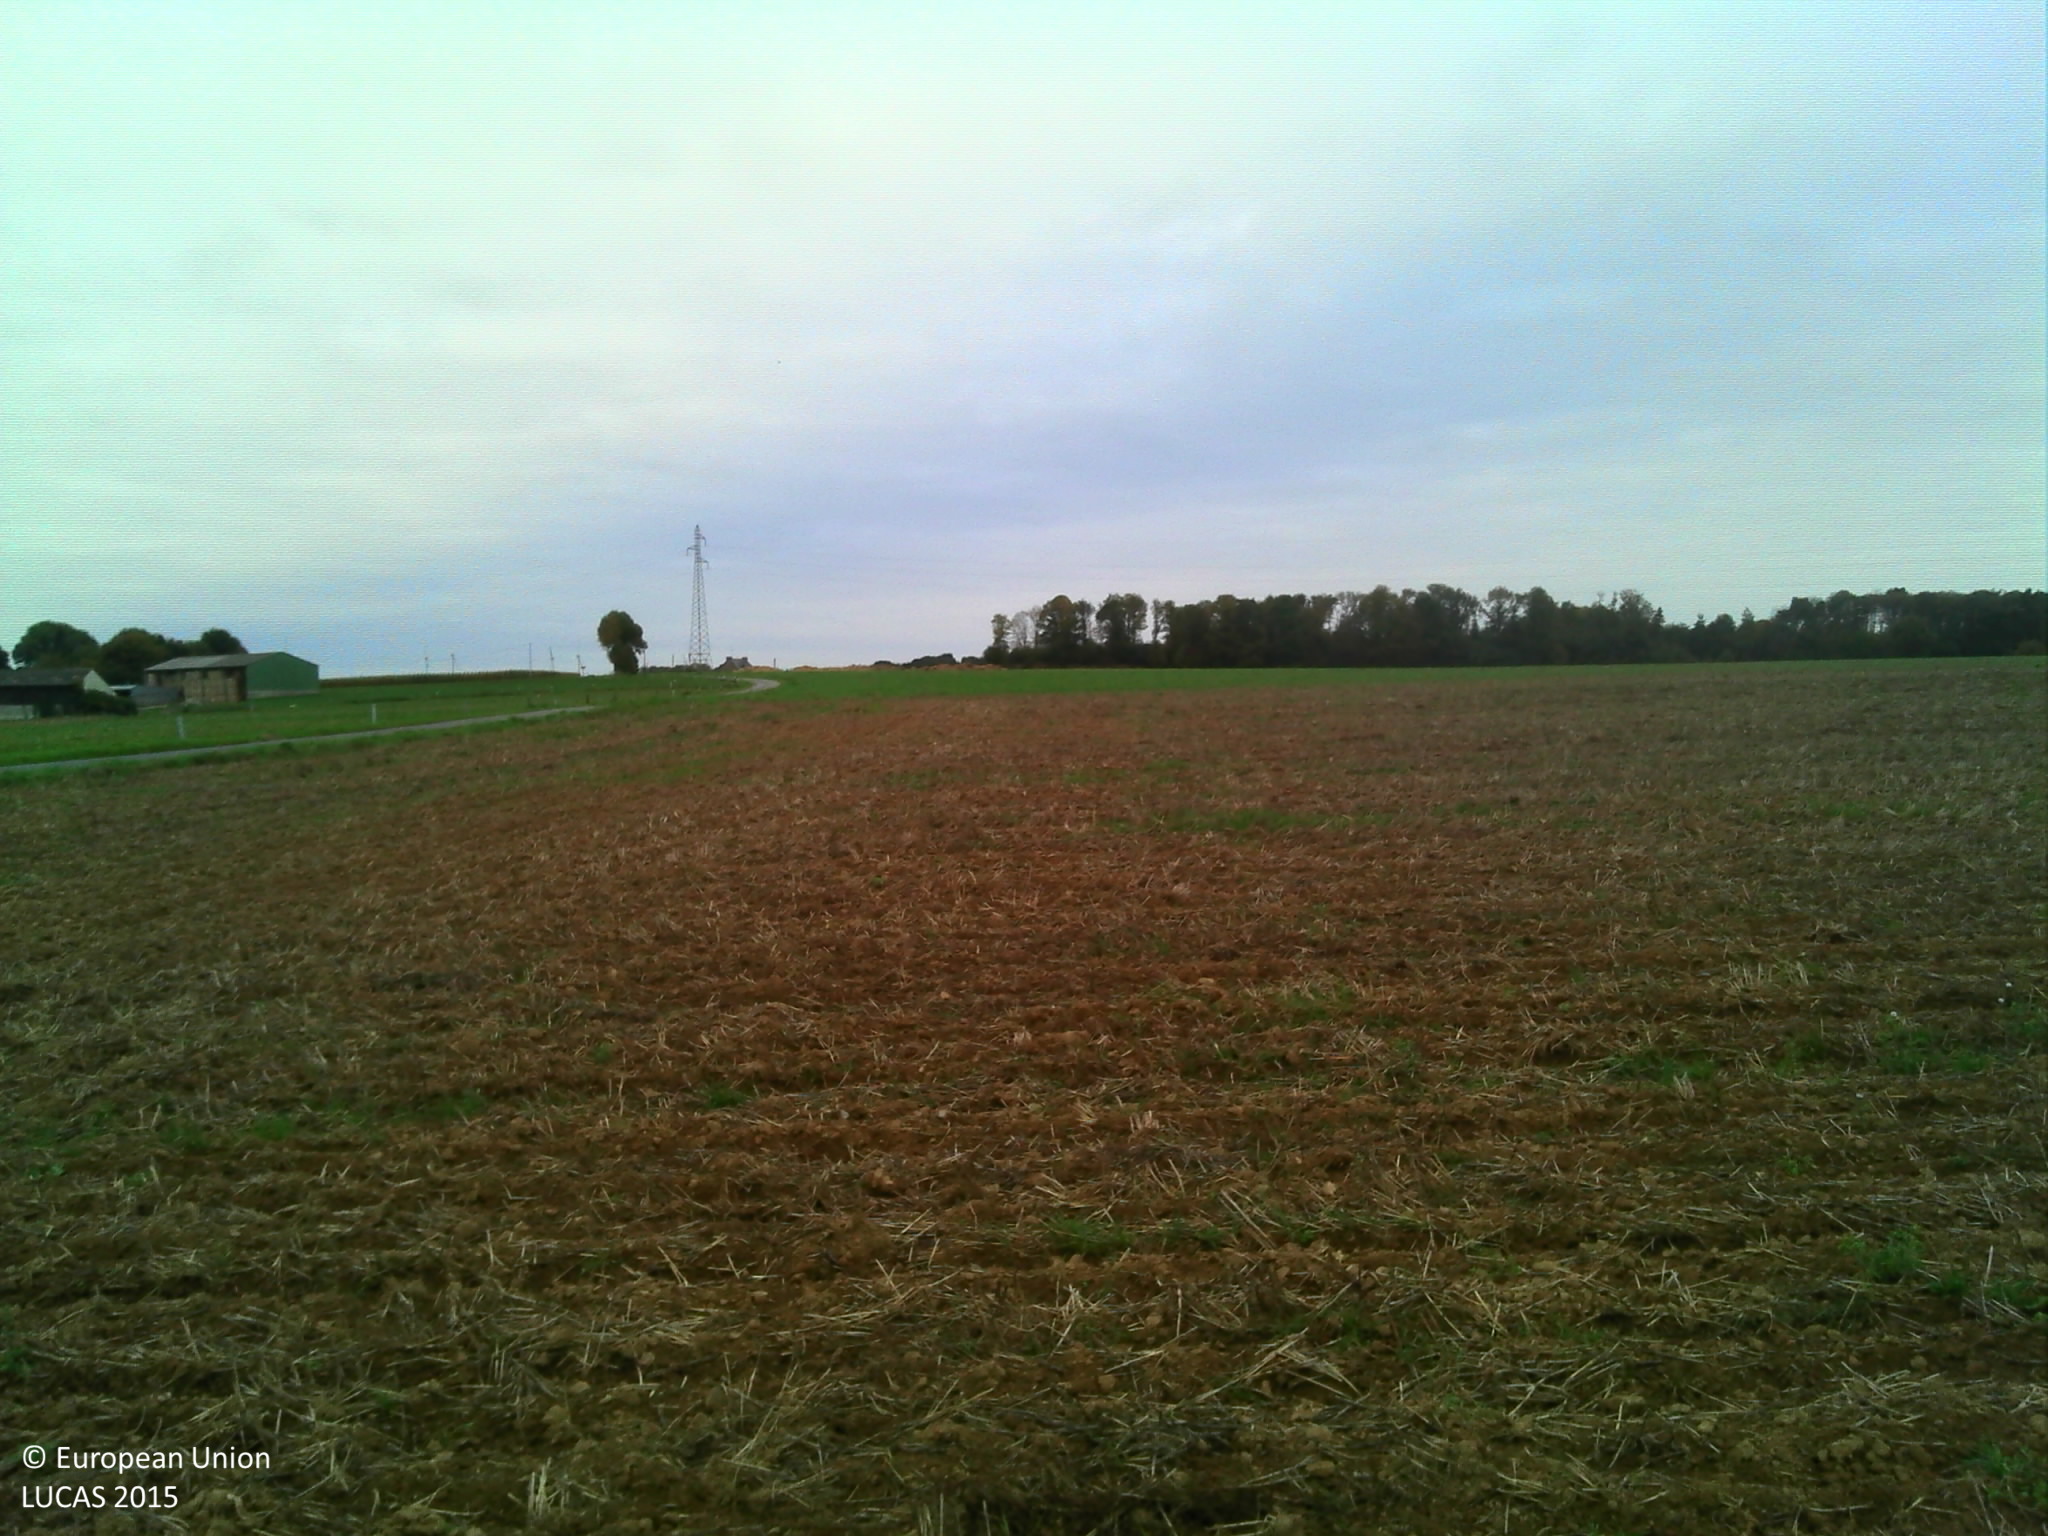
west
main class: Cropland
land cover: Common wheat
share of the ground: < 10 %
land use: Agriculture (excluding fallow land and kitchen gardens)
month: October
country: FR
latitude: 48.1382
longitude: -2.4087
